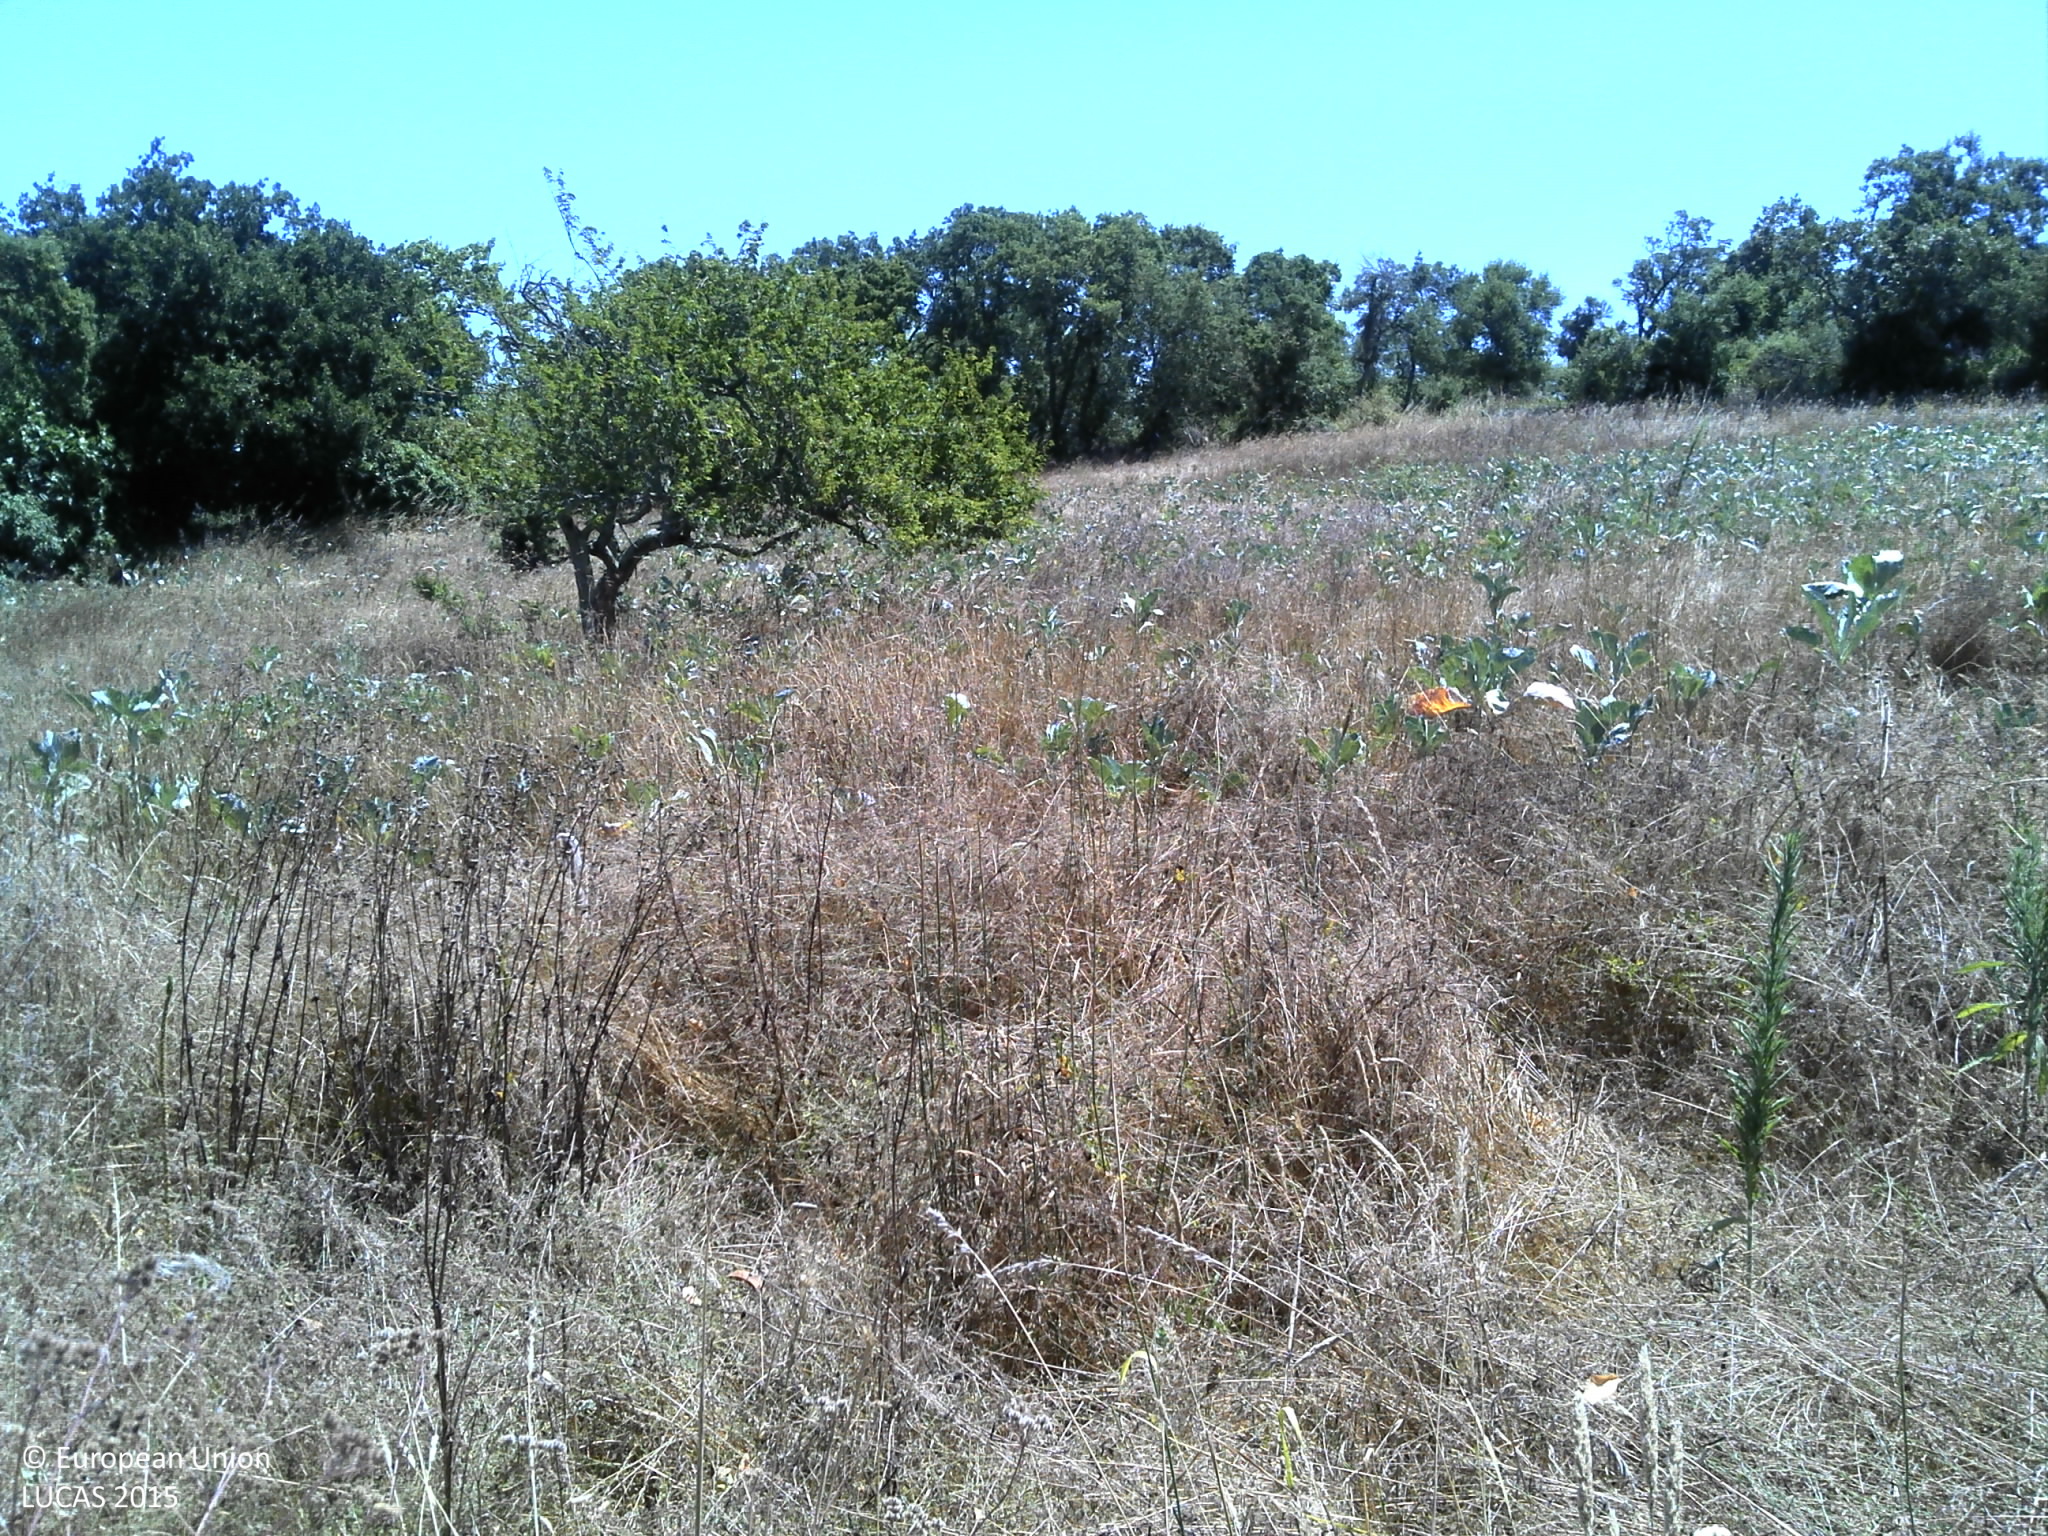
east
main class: Grassland
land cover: Grassland without tree/shrub cover
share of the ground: 50 - 75 %
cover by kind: herbaceous plants 70 %, unconsolidated bare surface 5 %
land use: Agriculture (excluding fallow land and kitchen gardens)
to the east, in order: Grassland without tree/shrub cover; Other fresh vegetables; Broadleaved woodland; Other bare soil; Single bushes/trees; Other bare soil; Shruby margins; Rivers and streams; Shruby margins; Grassland with sparse tree/shrub cover; Abandoned hedges; Ditches and canals; Paved roads, cycling and walking lanes; Grass margins; Shruby margins; Other fresh vegetables; Tracks; Grassland without tree/shrub cover; Artificial constructions in urban areas
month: July
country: PT
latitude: 38.9395
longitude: -9.2217
